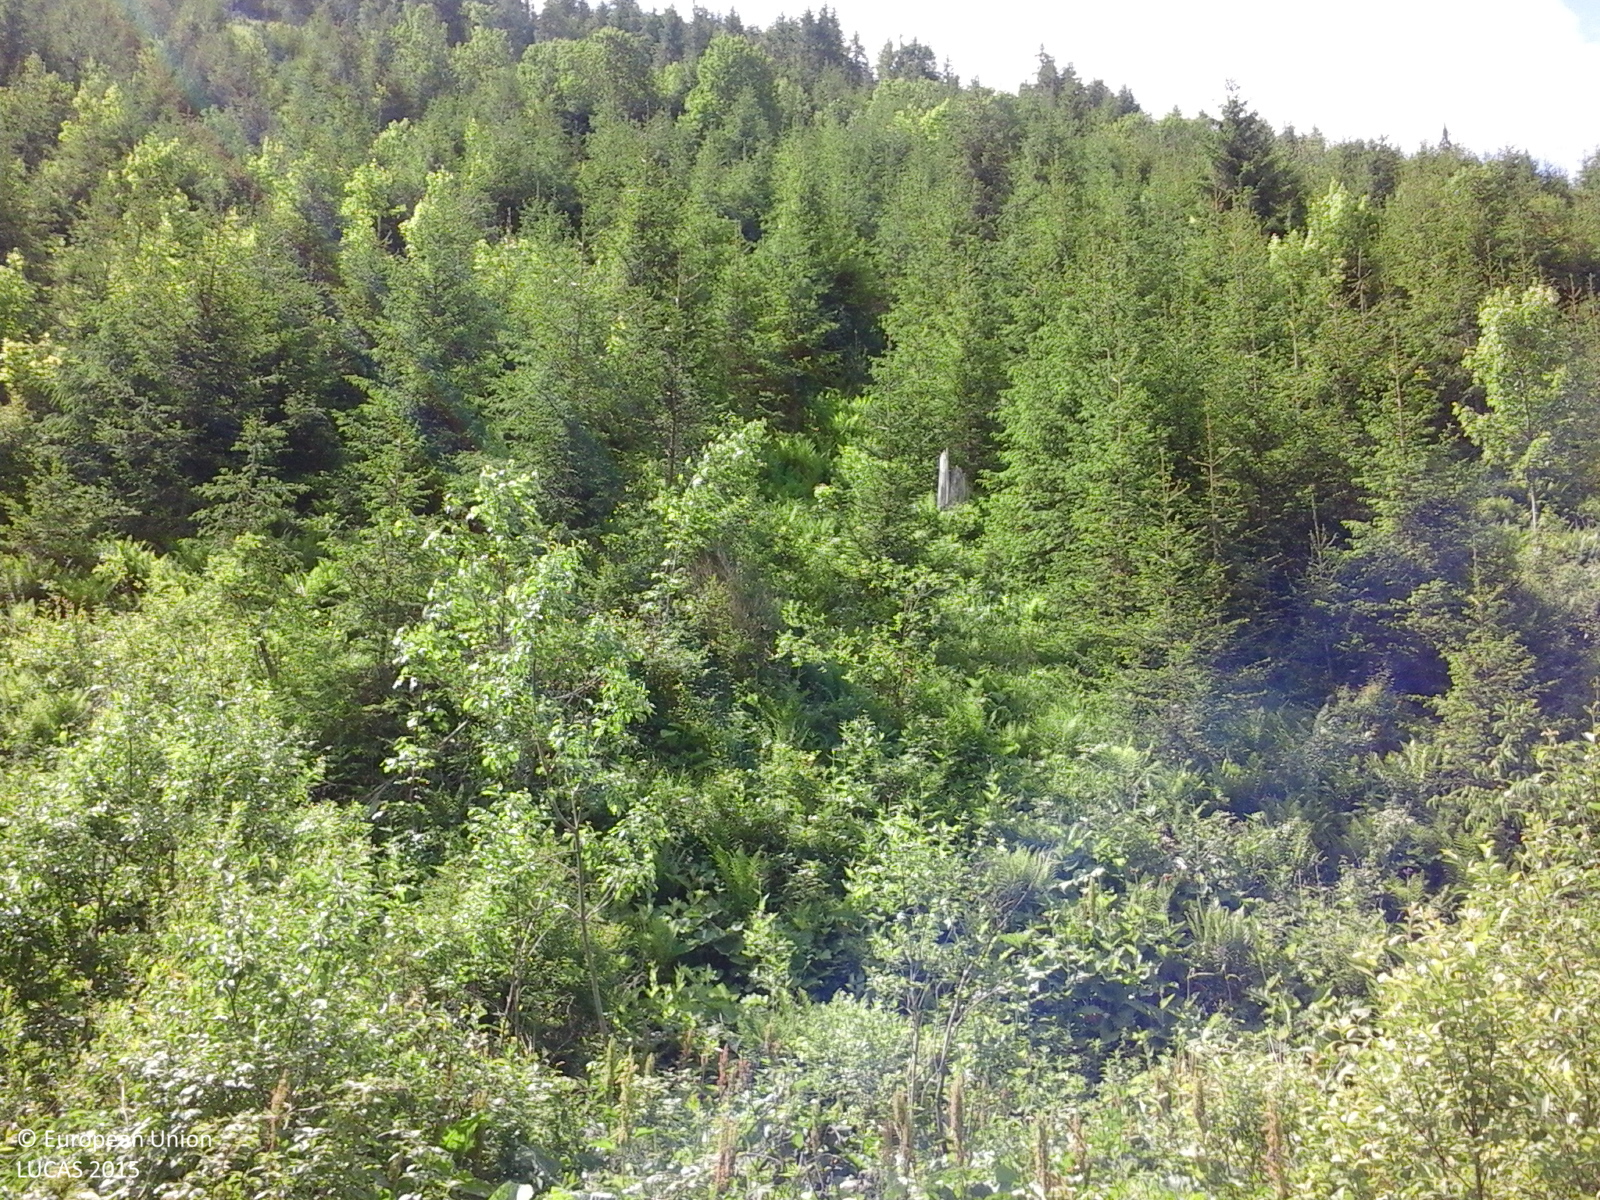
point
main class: Woodland
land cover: Spruce dominated mixed woodland
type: alpine coniferous forest
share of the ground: > 75 %
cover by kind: coniferous forest trees 75 %, broadleaved forest trees 25 %
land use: Forestry
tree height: > 5 m
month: June
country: RO
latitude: 47.2985
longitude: 25.5221
